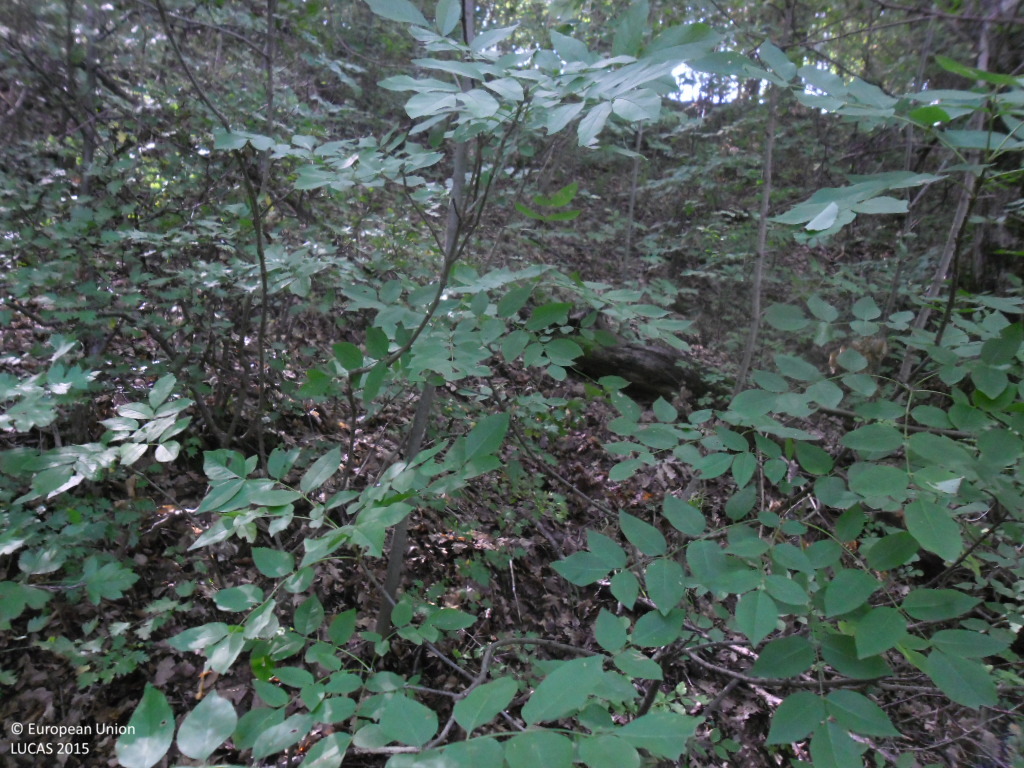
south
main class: Woodland
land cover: Broadleaved woodland
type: mountainous beech forest
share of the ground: > 75 %
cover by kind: broadleaved forest trees 95 %, unconsolidated bare surface 5 %
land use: Forestry
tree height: > 5 m
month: September
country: BG
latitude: 41.8675
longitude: 22.9969
